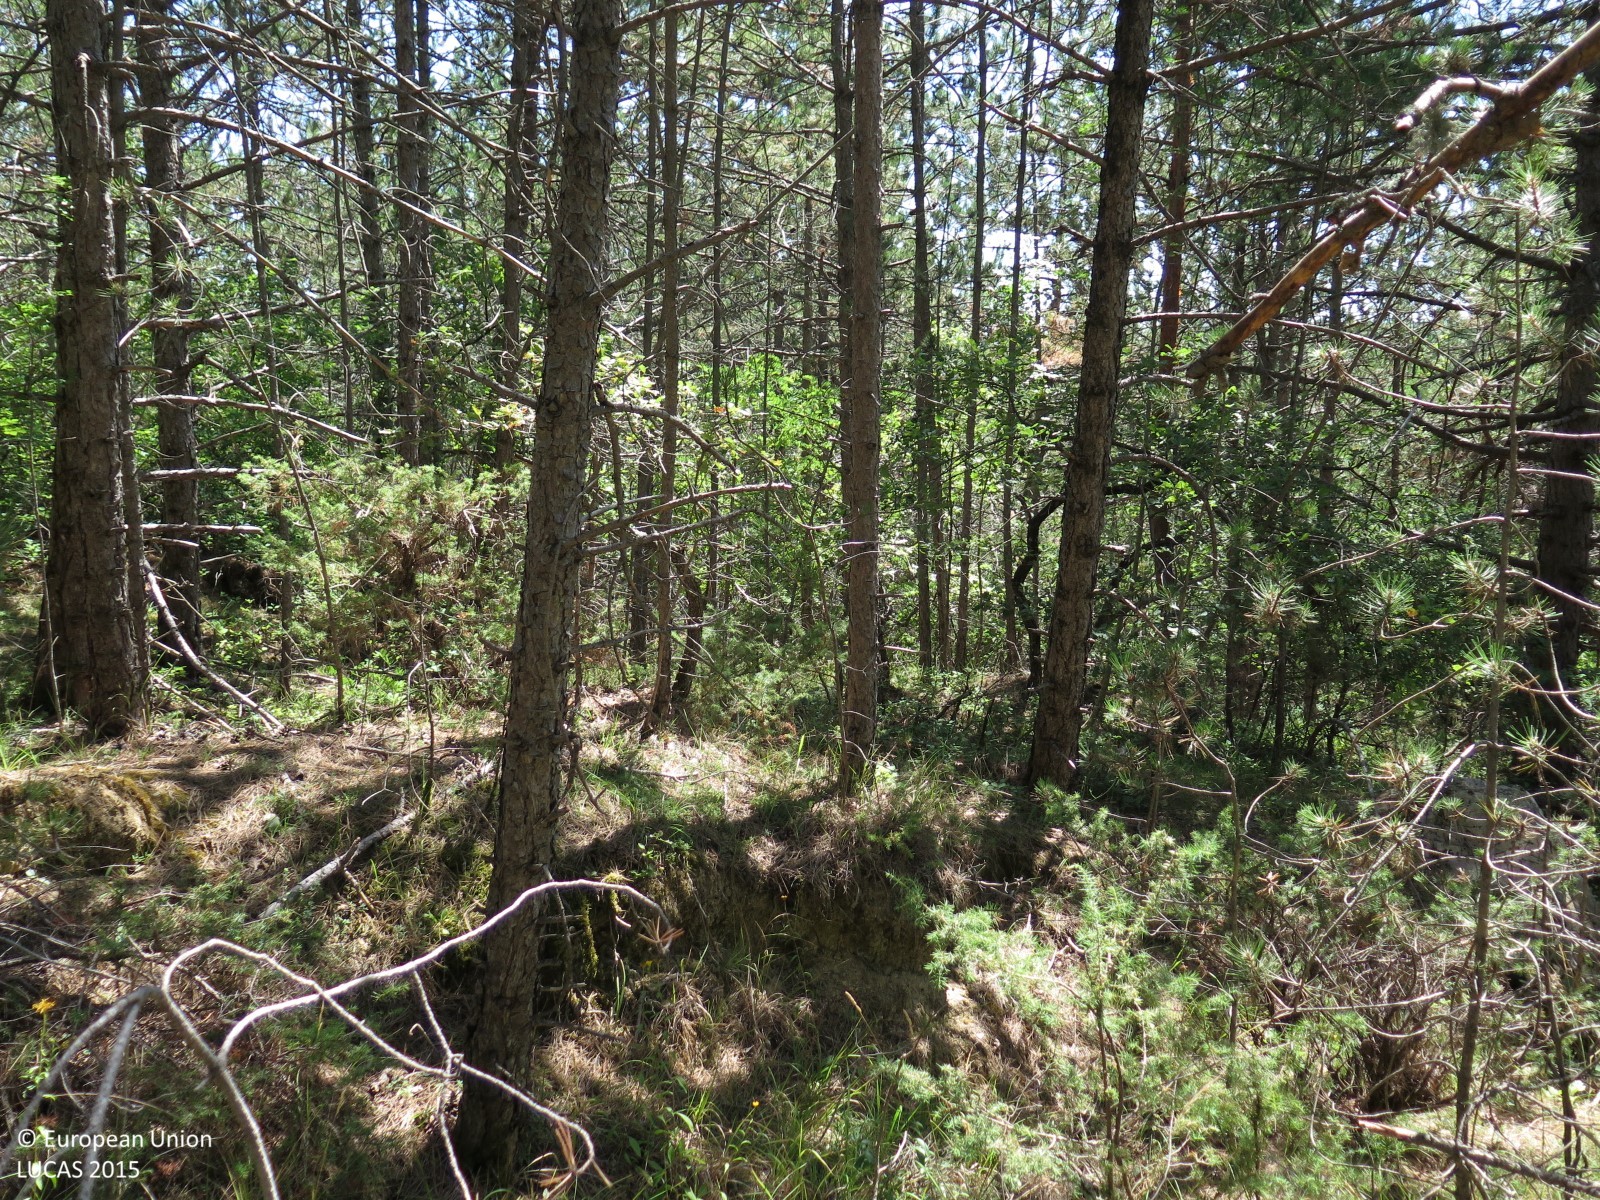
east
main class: Woodland
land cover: Pine dominated mixed woodland
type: coniferous forest of the mediterranean region
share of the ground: > 75 %
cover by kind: coniferous forest trees 75 %, broadleaved forest trees 25 %
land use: Semi-natural and natural areas not in use
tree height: > 5 m
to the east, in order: Pine dominated mixed woodland; Rivers and streams; Pine dominated mixed woodland; Ditches and canals; Pine dominated mixed woodland; Grass margins; Paved roads, cycling and walking lanes; Grass margins; Shrubland with sparse tree cover; Grassland without tree/shrub cover; Pine dominated mixed woodland
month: July
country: HR
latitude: 45.4183
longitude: 13.7906
